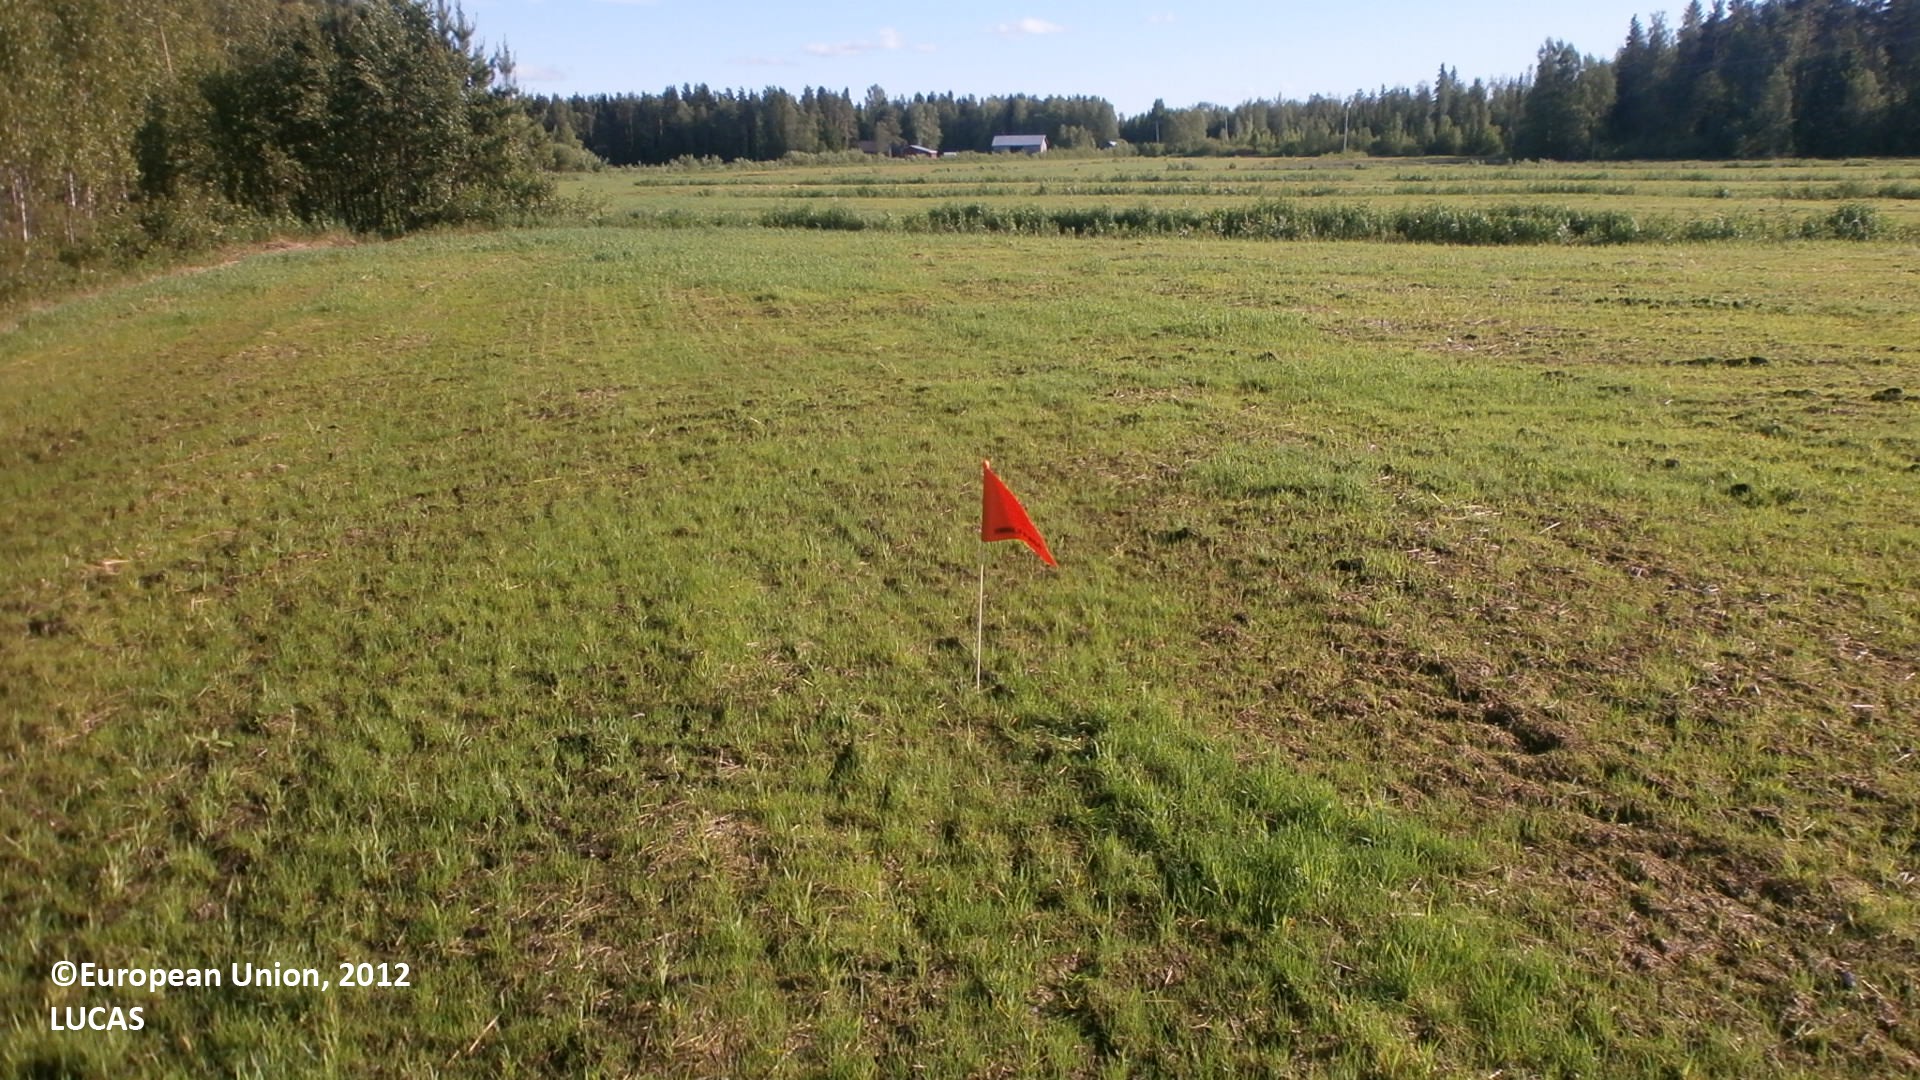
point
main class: Cropland
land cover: Temporary grasslands
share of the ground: 25 - 50 %
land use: Agriculture (excluding fallow land and kitchen gardens)
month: June
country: FI
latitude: 64.4350
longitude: 25.0132
